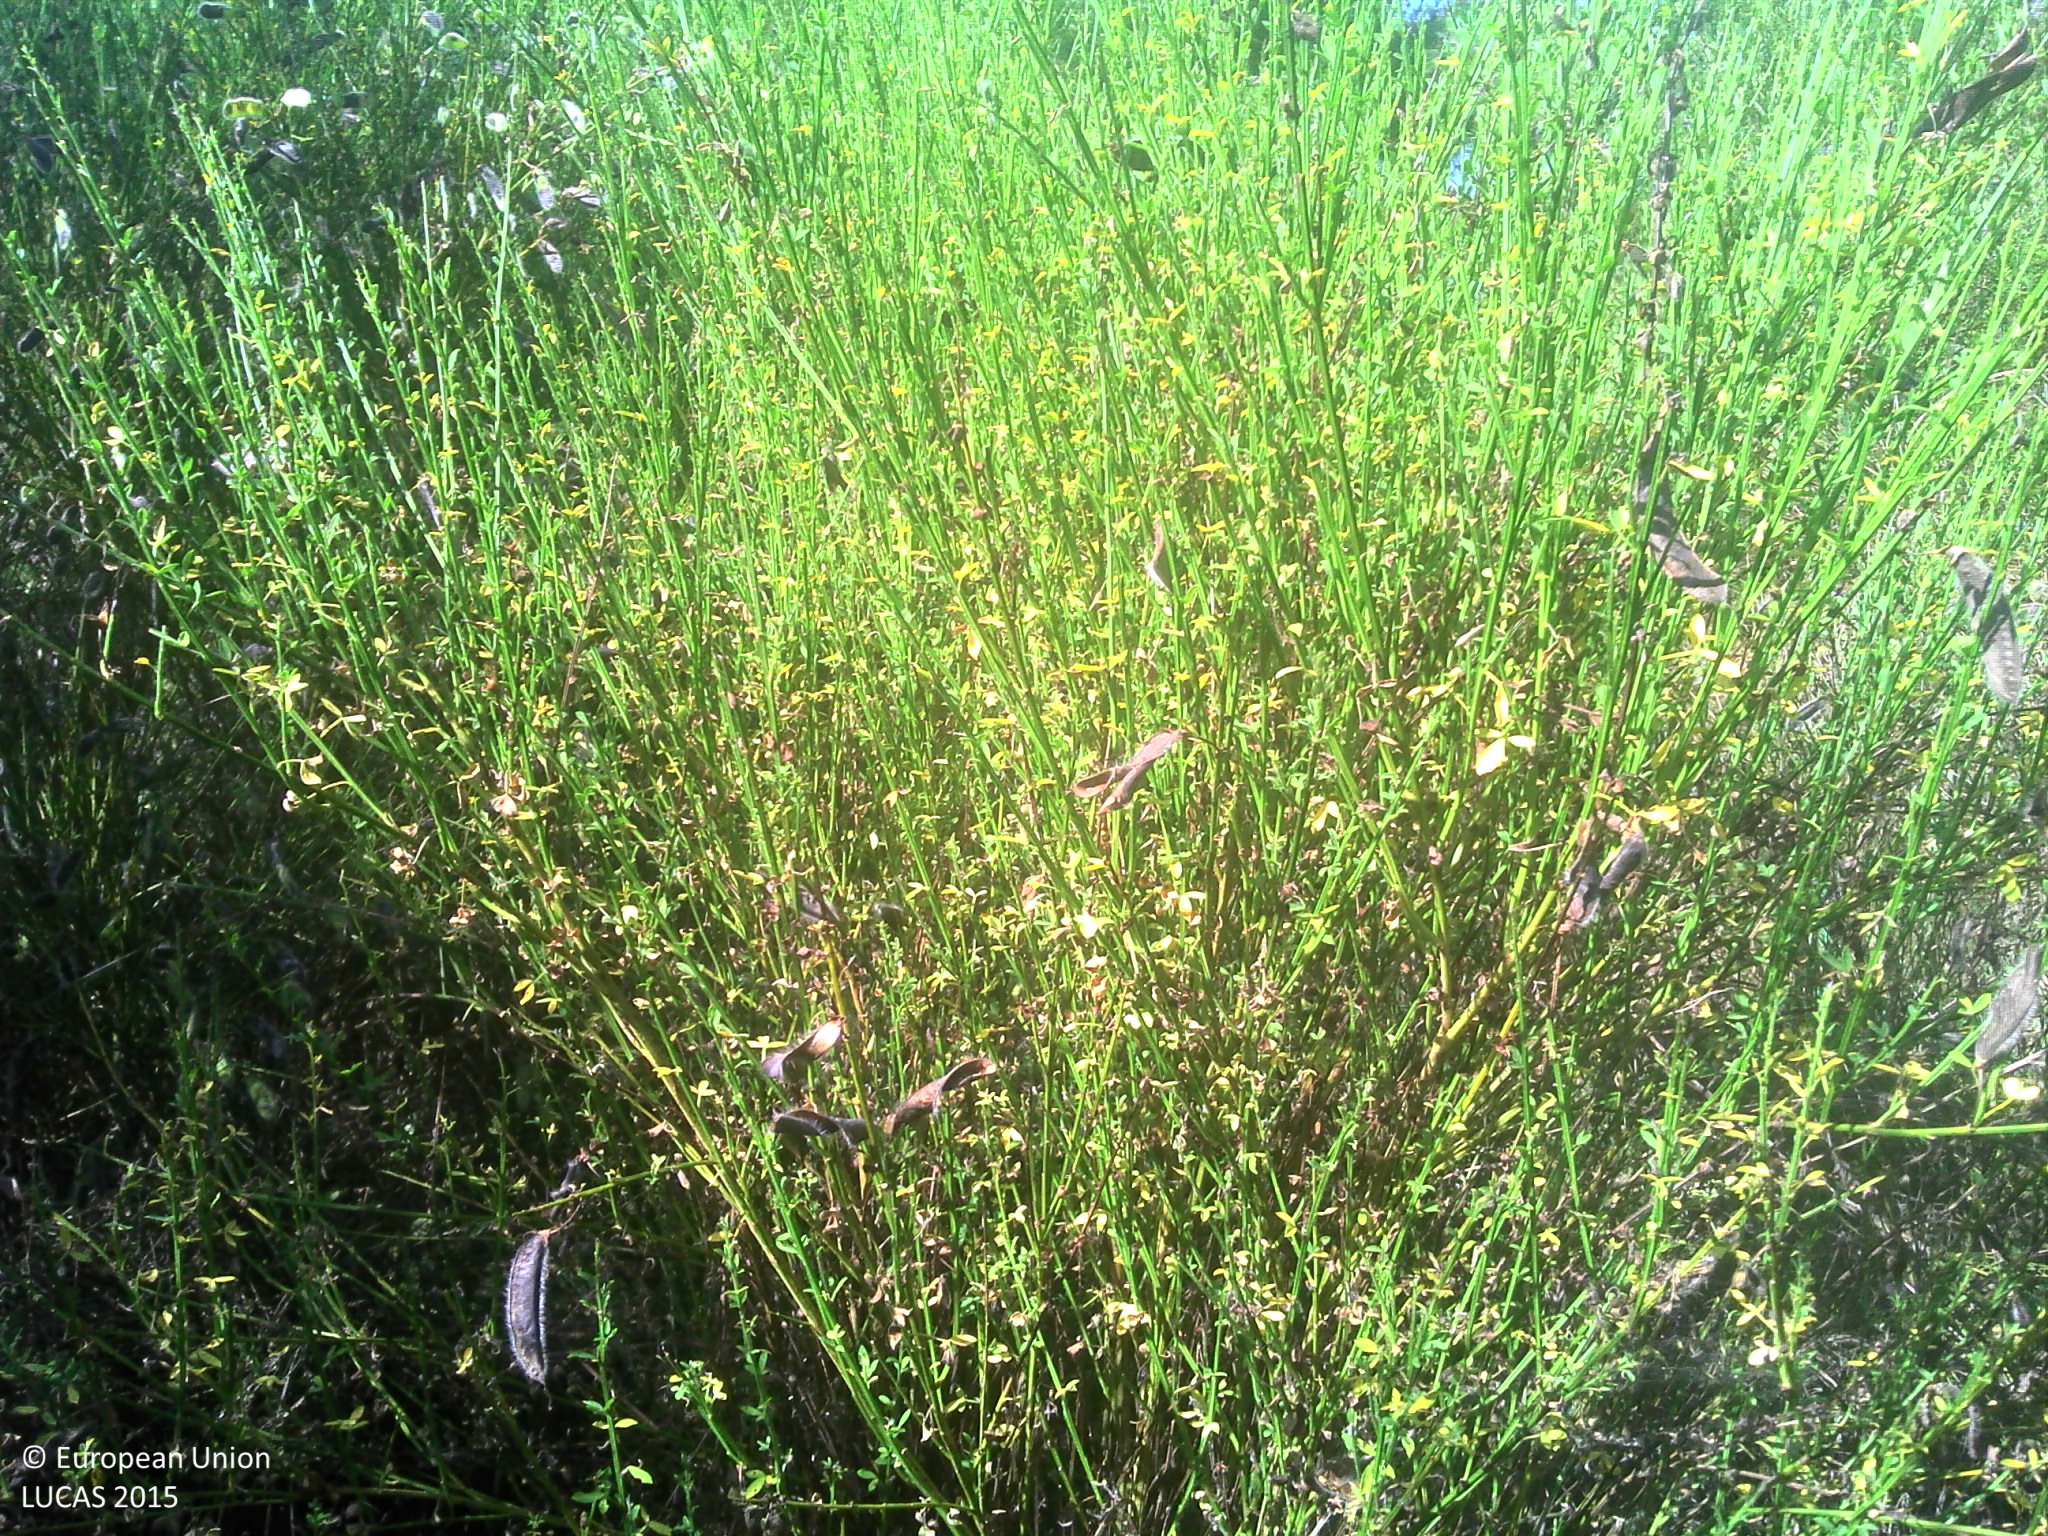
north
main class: Woodland
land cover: Pine dominated coniferous woodland
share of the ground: > 75 %
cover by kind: coniferous forest trees 50 %, lichens and mosses 20 %, unconsolidated bare surface 20 %, herbaceous plants 10 %
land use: Forestry
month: June
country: FR
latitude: 47.2806
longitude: 1.5127
